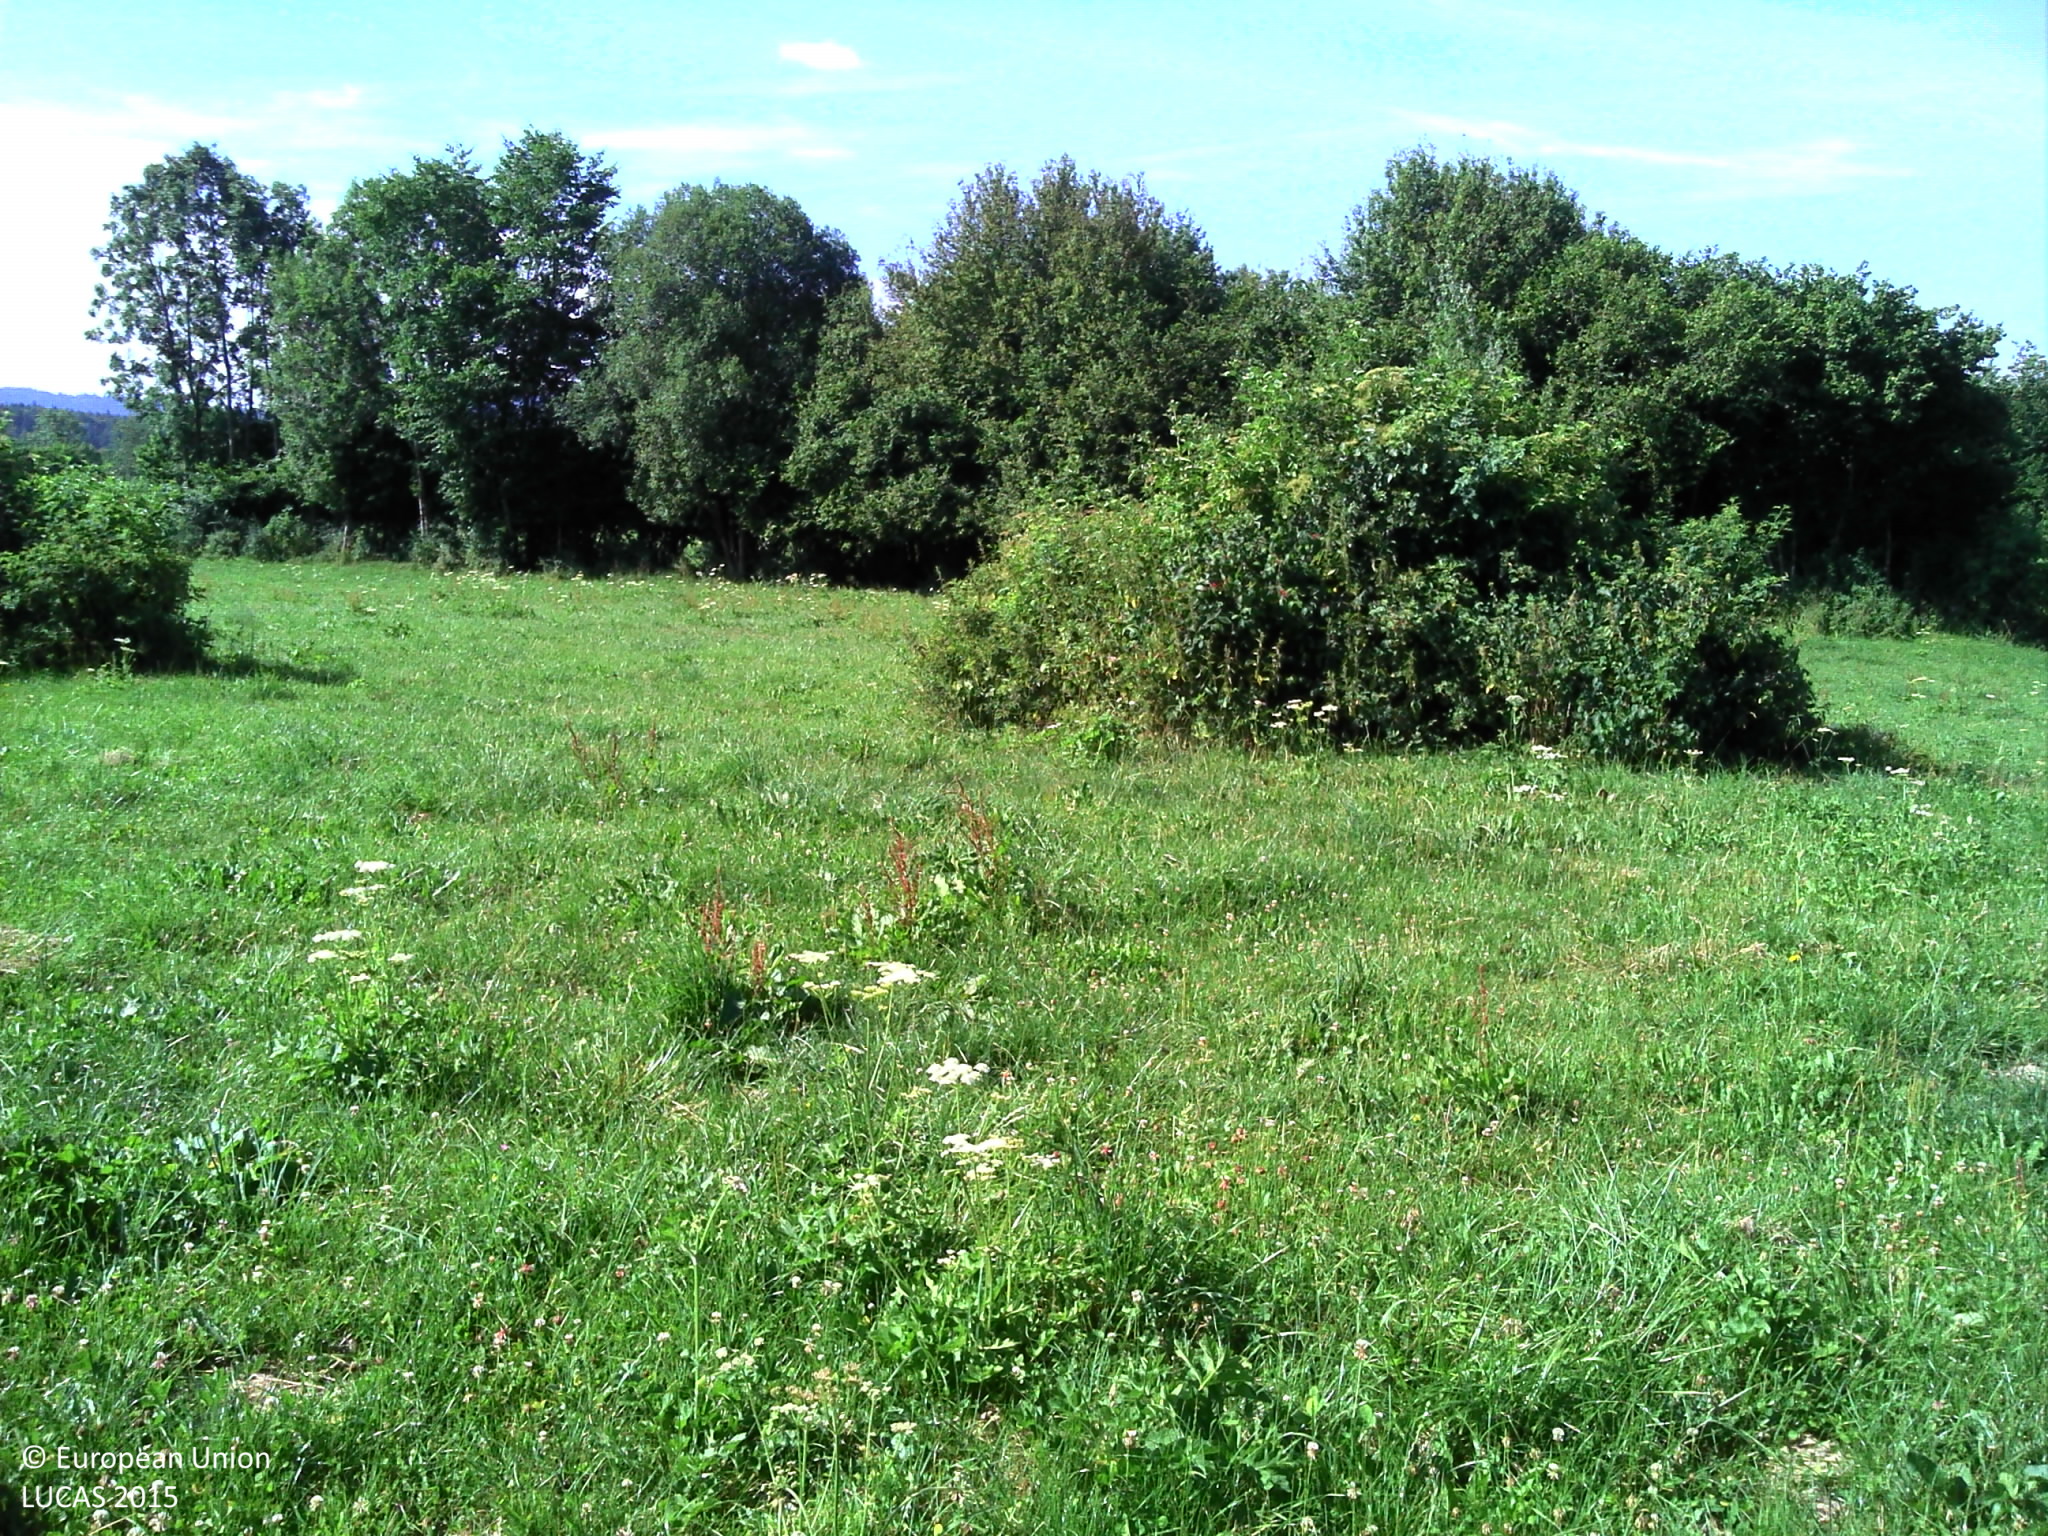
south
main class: Shrubland
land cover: Shrubland without tree cover
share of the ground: > 75 %
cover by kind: shrubs 100 %
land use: Agriculture (excluding fallow land and kitchen gardens)
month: July
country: FR
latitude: 46.7863
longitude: 6.1383
